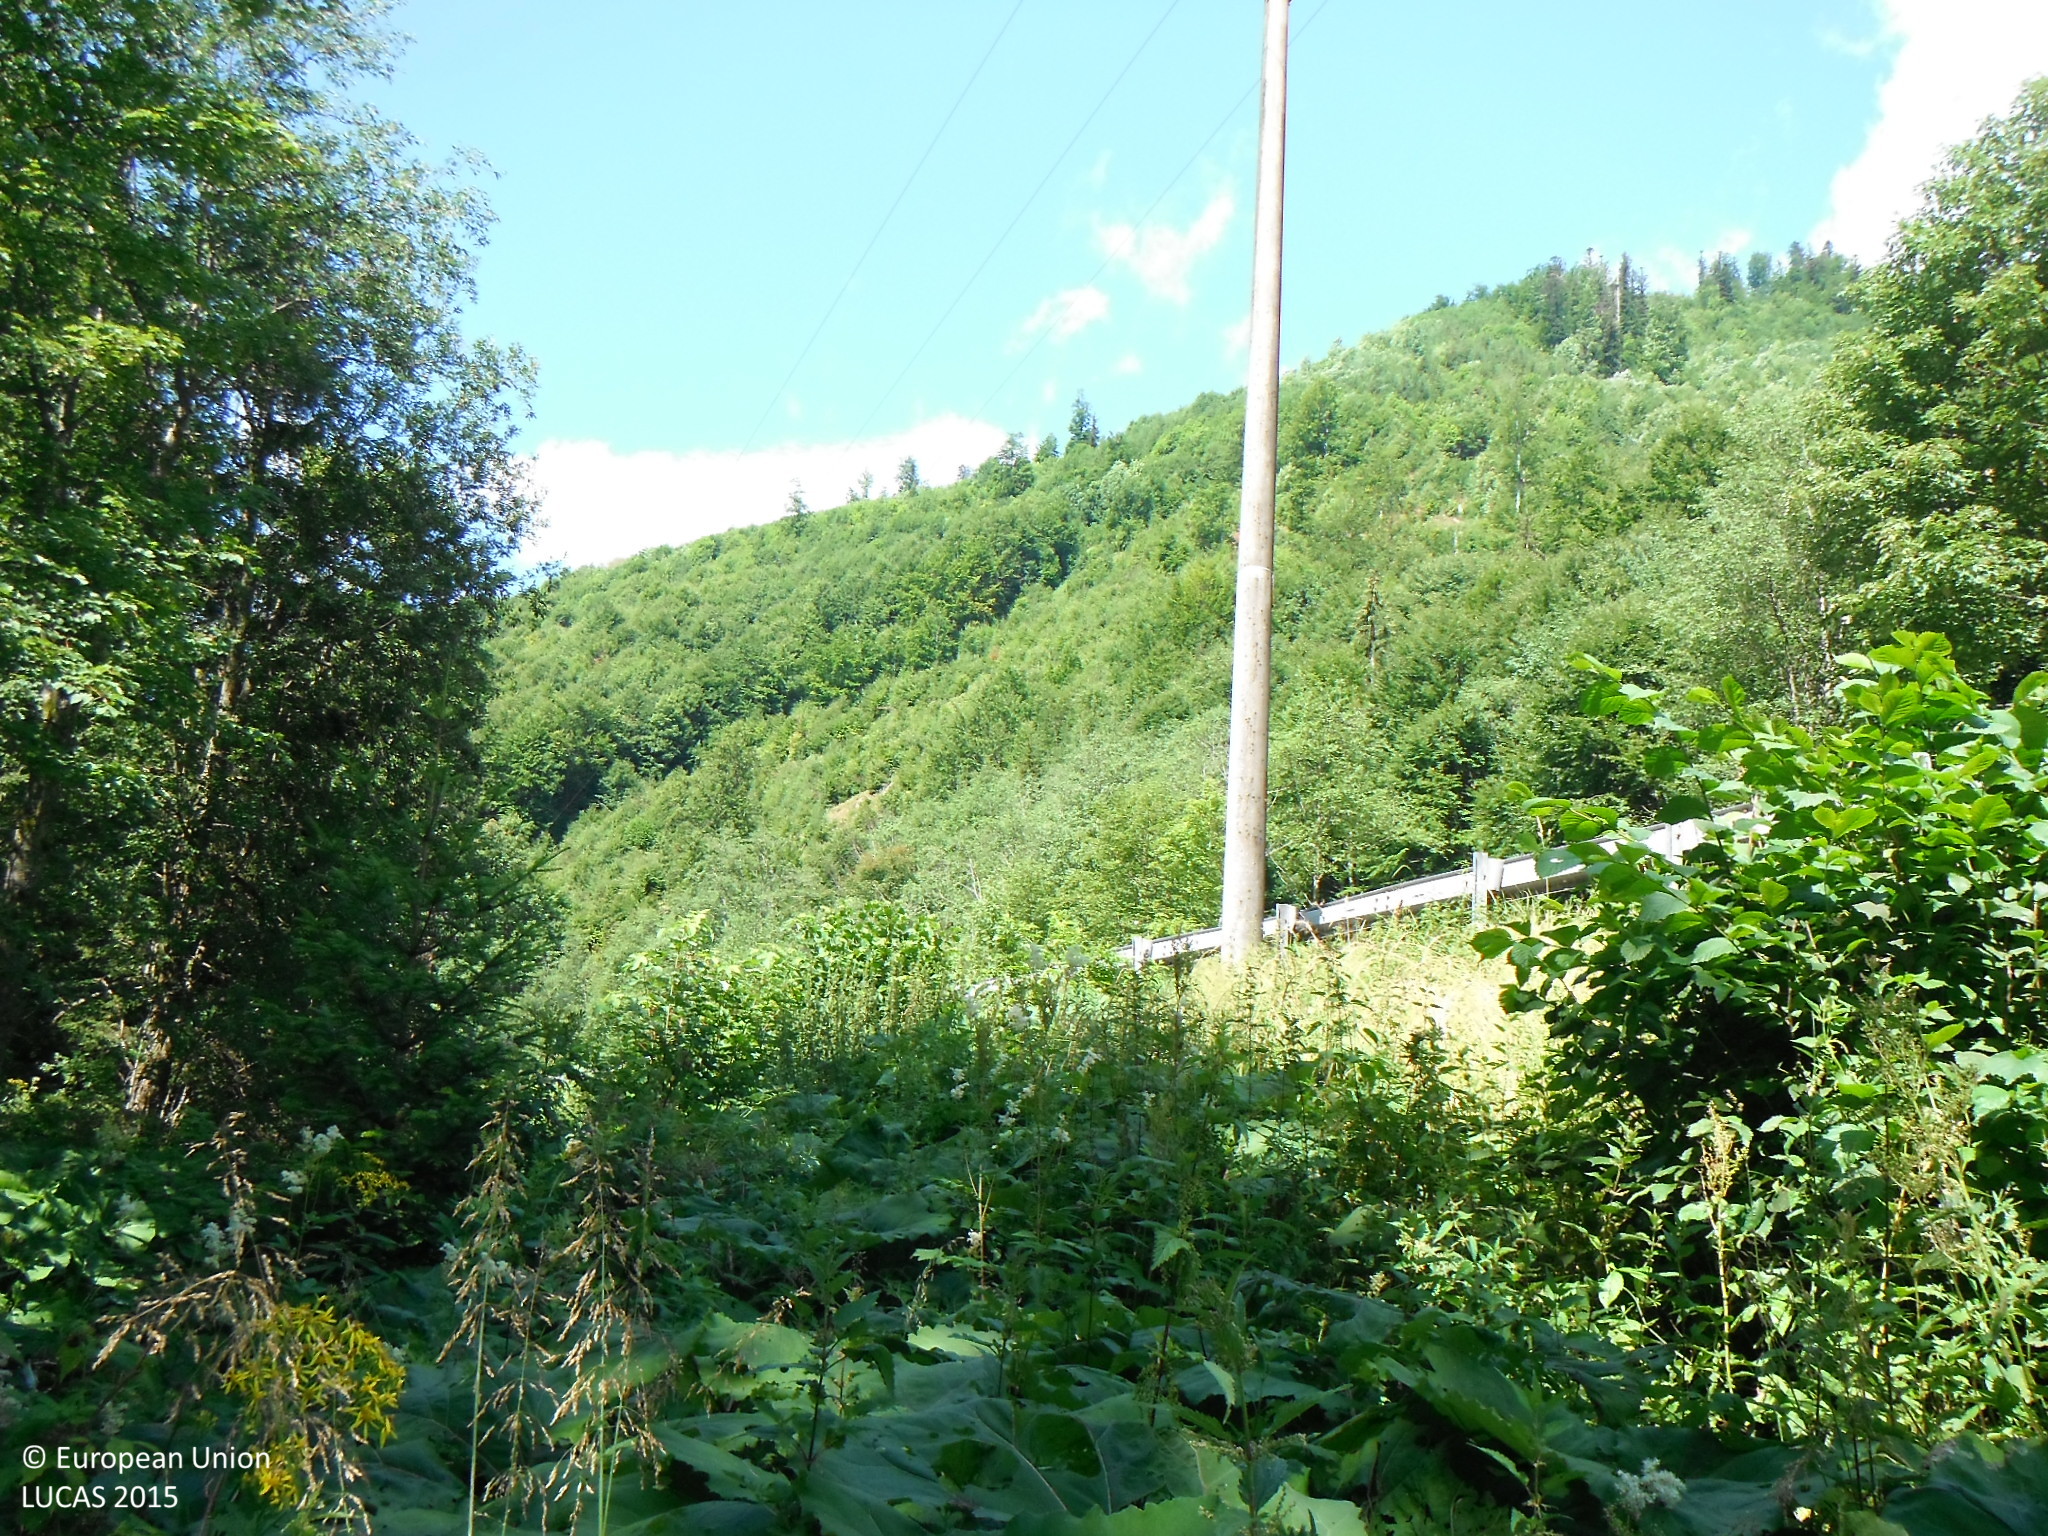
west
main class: Woodland
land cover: Spruce dominated mixed woodland
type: mountainous beech forest
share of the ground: > 75 %
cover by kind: broadleaved forest trees 50 %, coniferous forest trees 25 %, shrubs 15 %, herbaceous plants 10 %
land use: Forestry
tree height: > 5 m
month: July
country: SK
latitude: 48.8848
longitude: 19.6689
